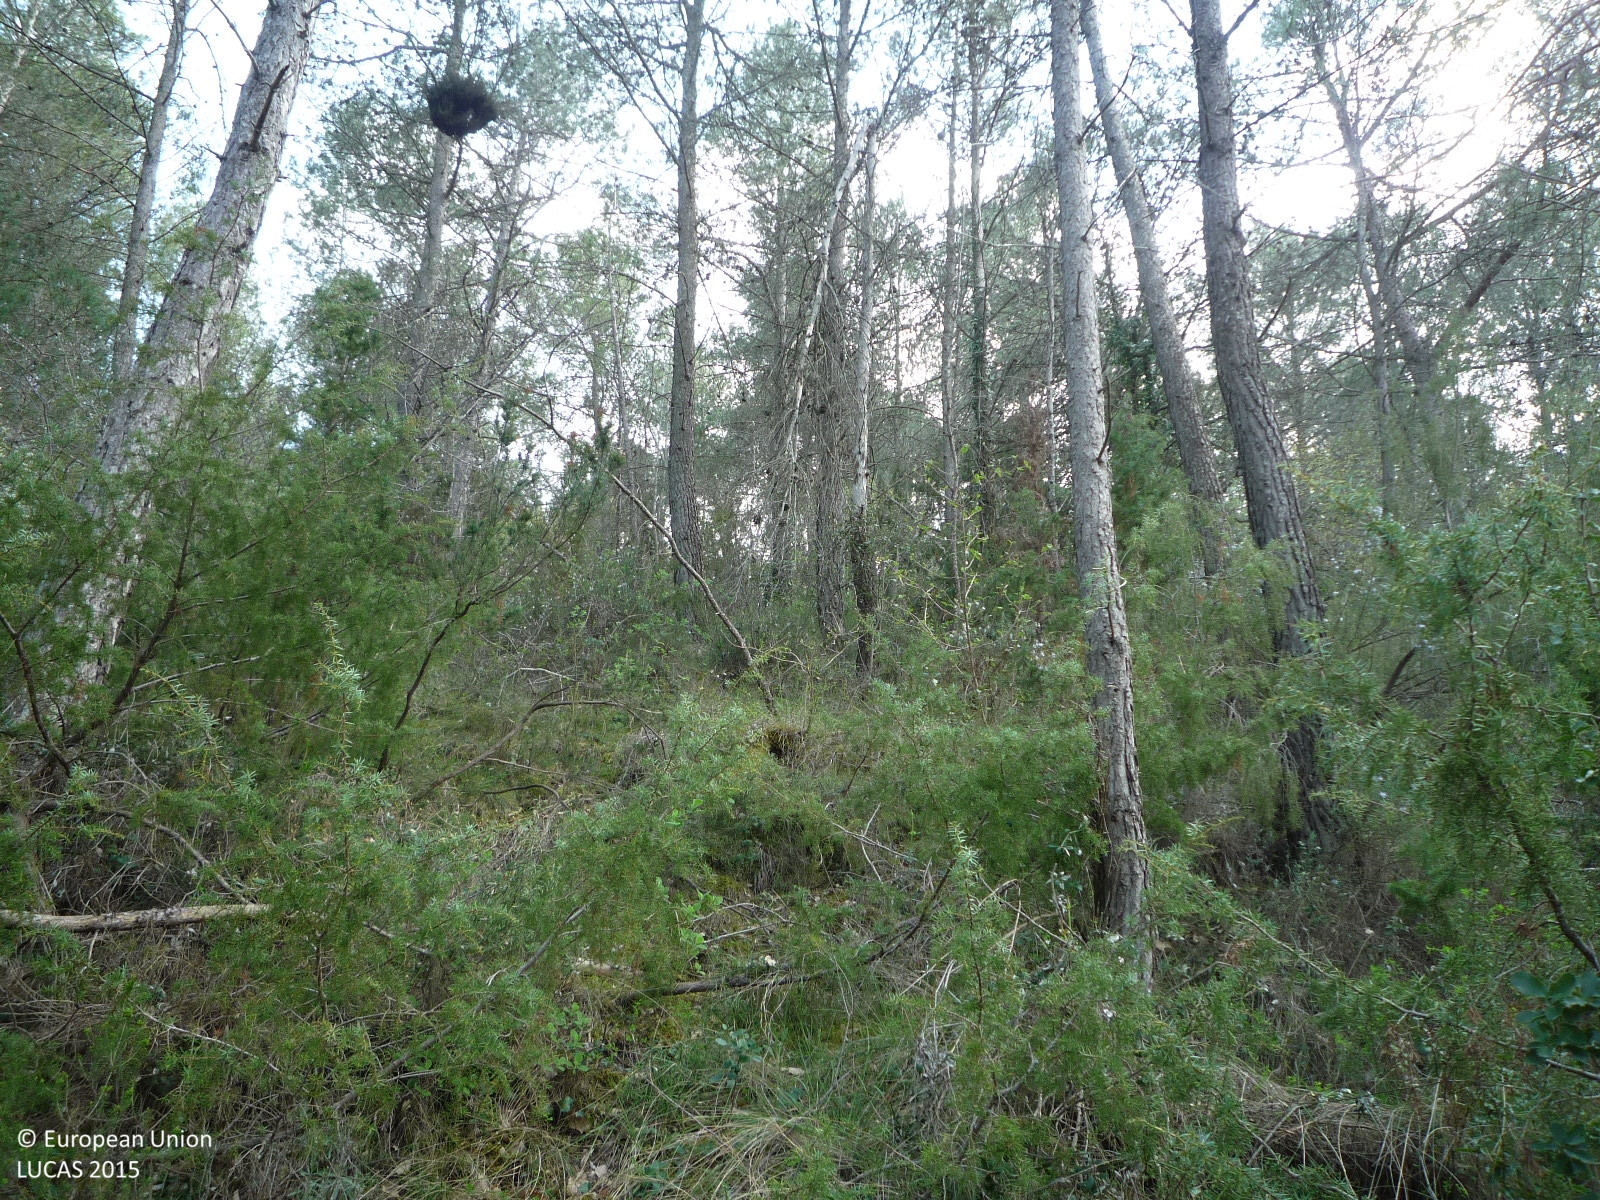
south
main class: Woodland
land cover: Pine dominated coniferous woodland
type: coniferous forest of the mediterranean region
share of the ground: > 75 %
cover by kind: coniferous forest trees 80 %, shrubs 20 %
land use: Forestry
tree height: > 5 m
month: April
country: ES
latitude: 41.5869
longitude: 1.4863
